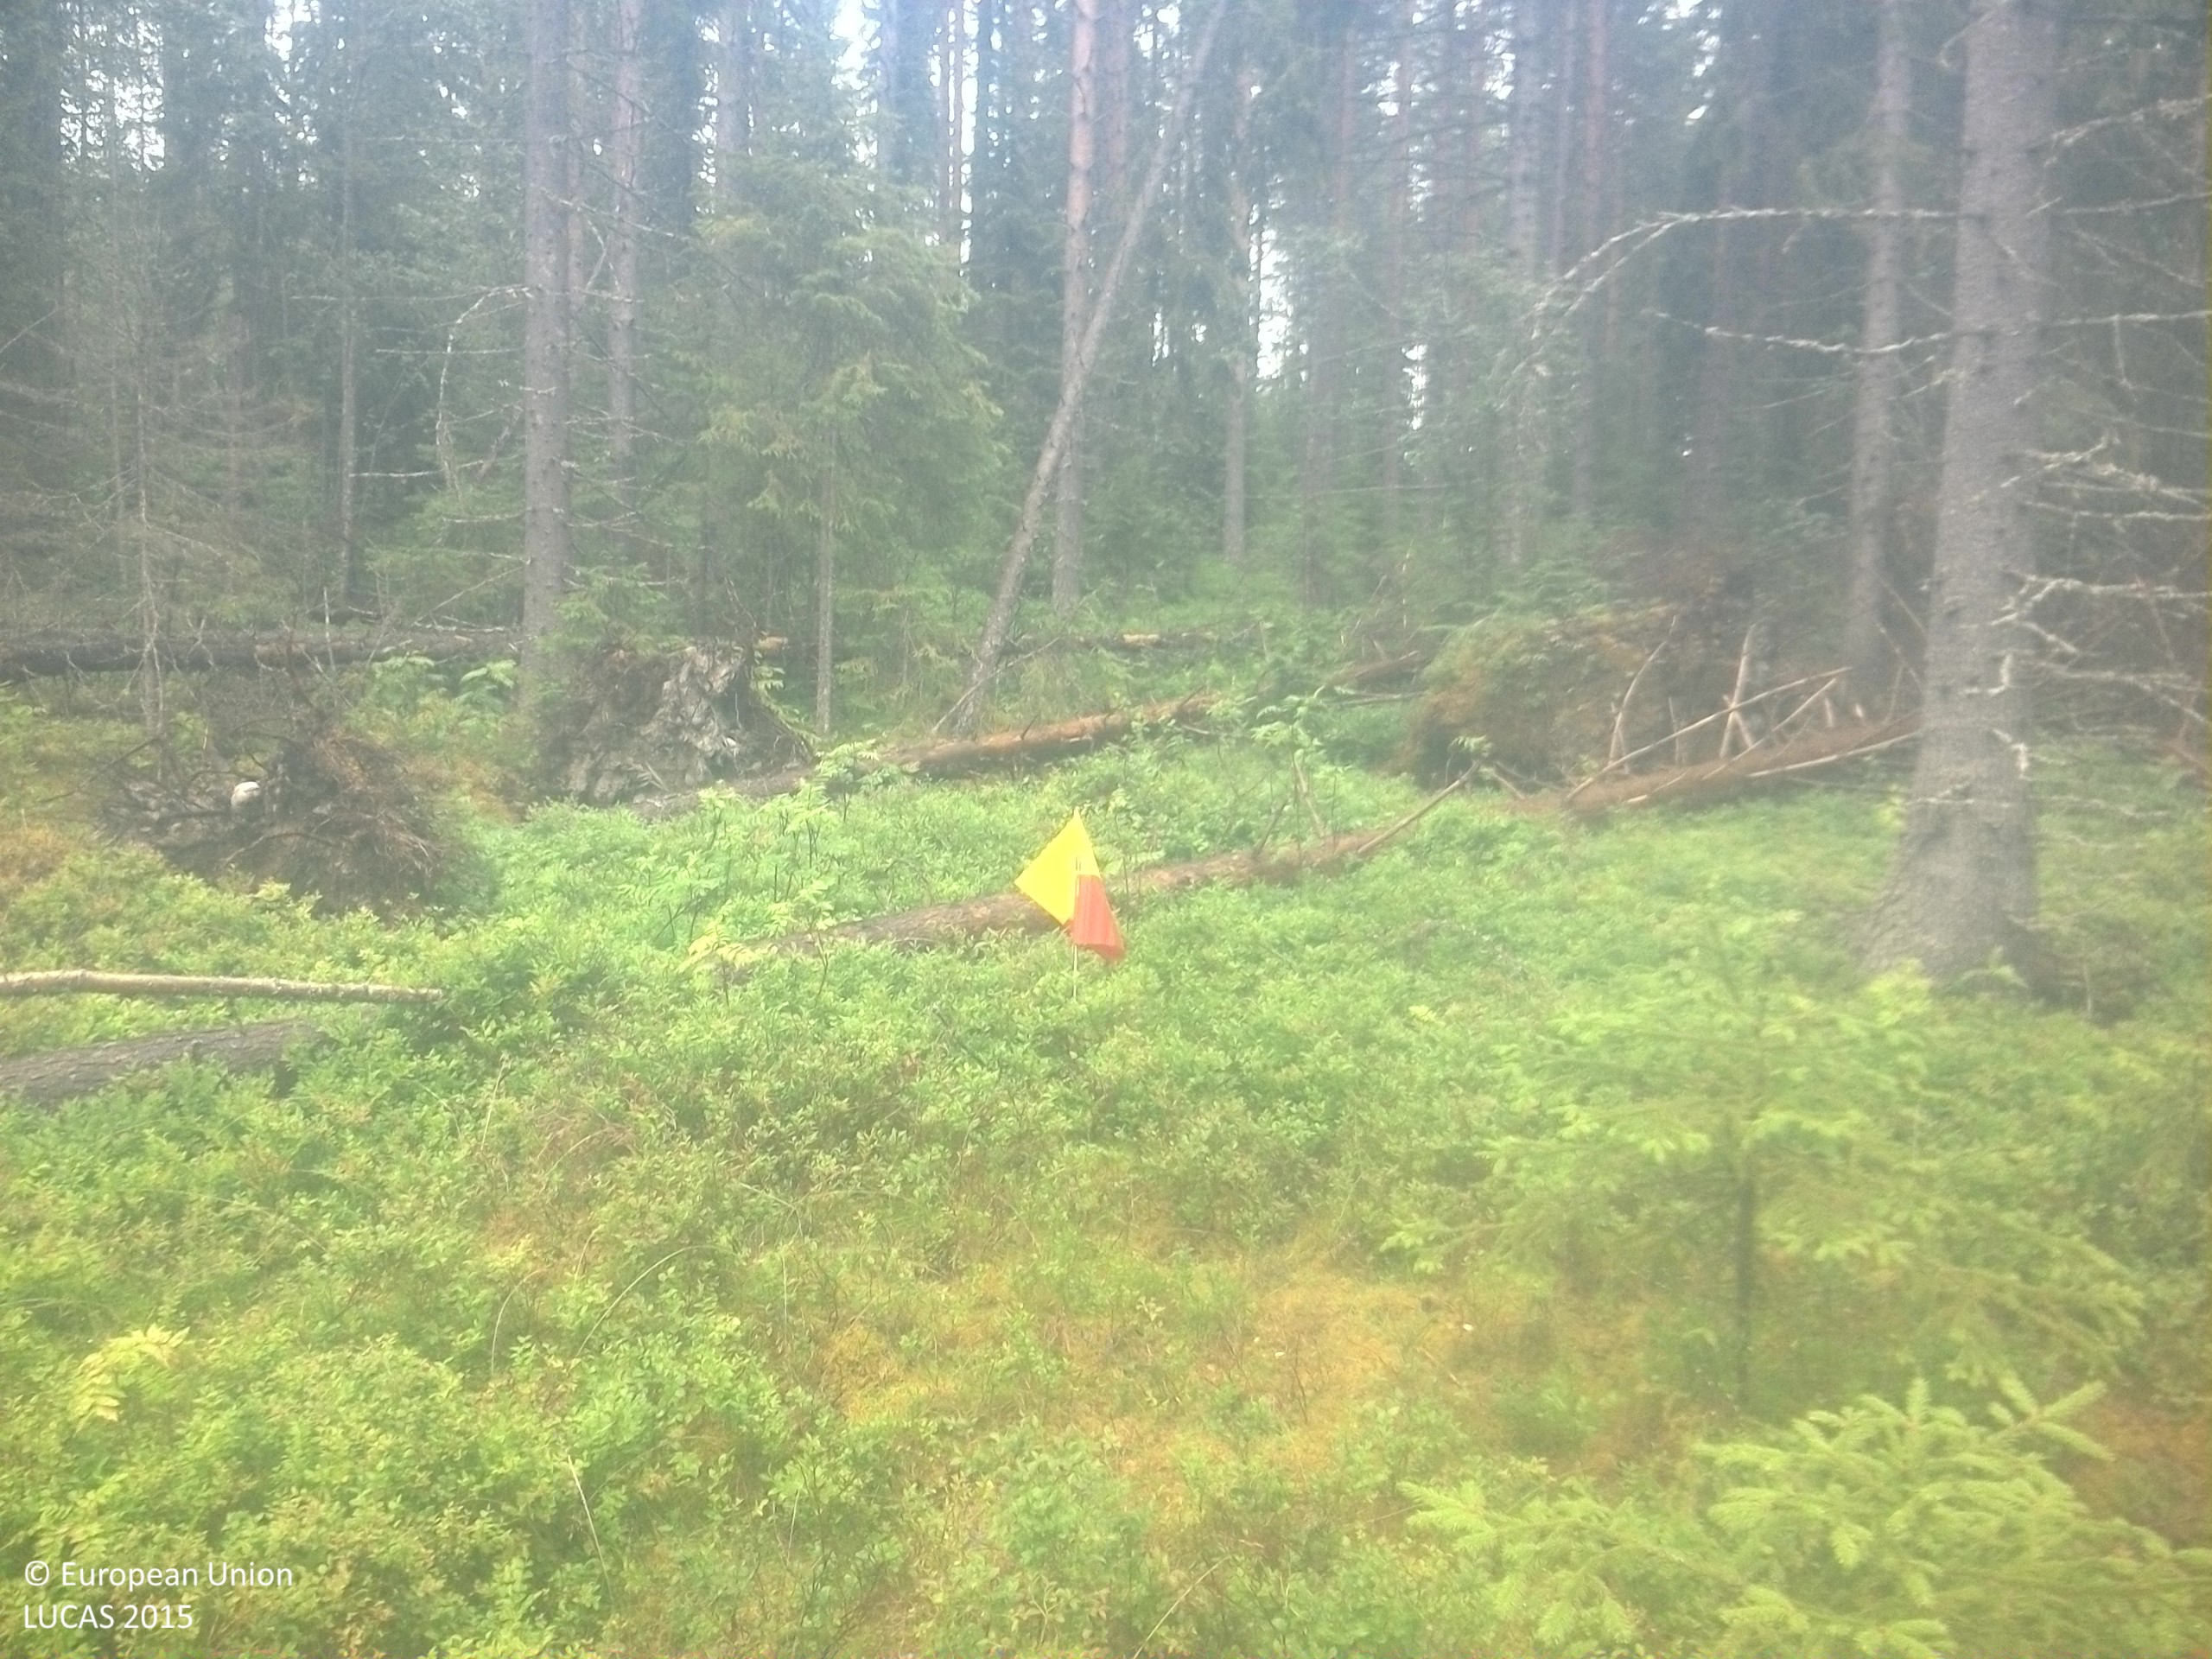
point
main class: Woodland
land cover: Other coniferous woodland
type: boreal forest
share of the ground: 25 - 50 %
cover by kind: coniferous forest trees 40 %, shrubs 40 %, lichens and mosses 10 %, broadleaved forest trees 5 %, herbaceous plants 5 %
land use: Forestry
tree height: > 5 m
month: August
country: SE
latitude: 63.5790
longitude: 16.4394
